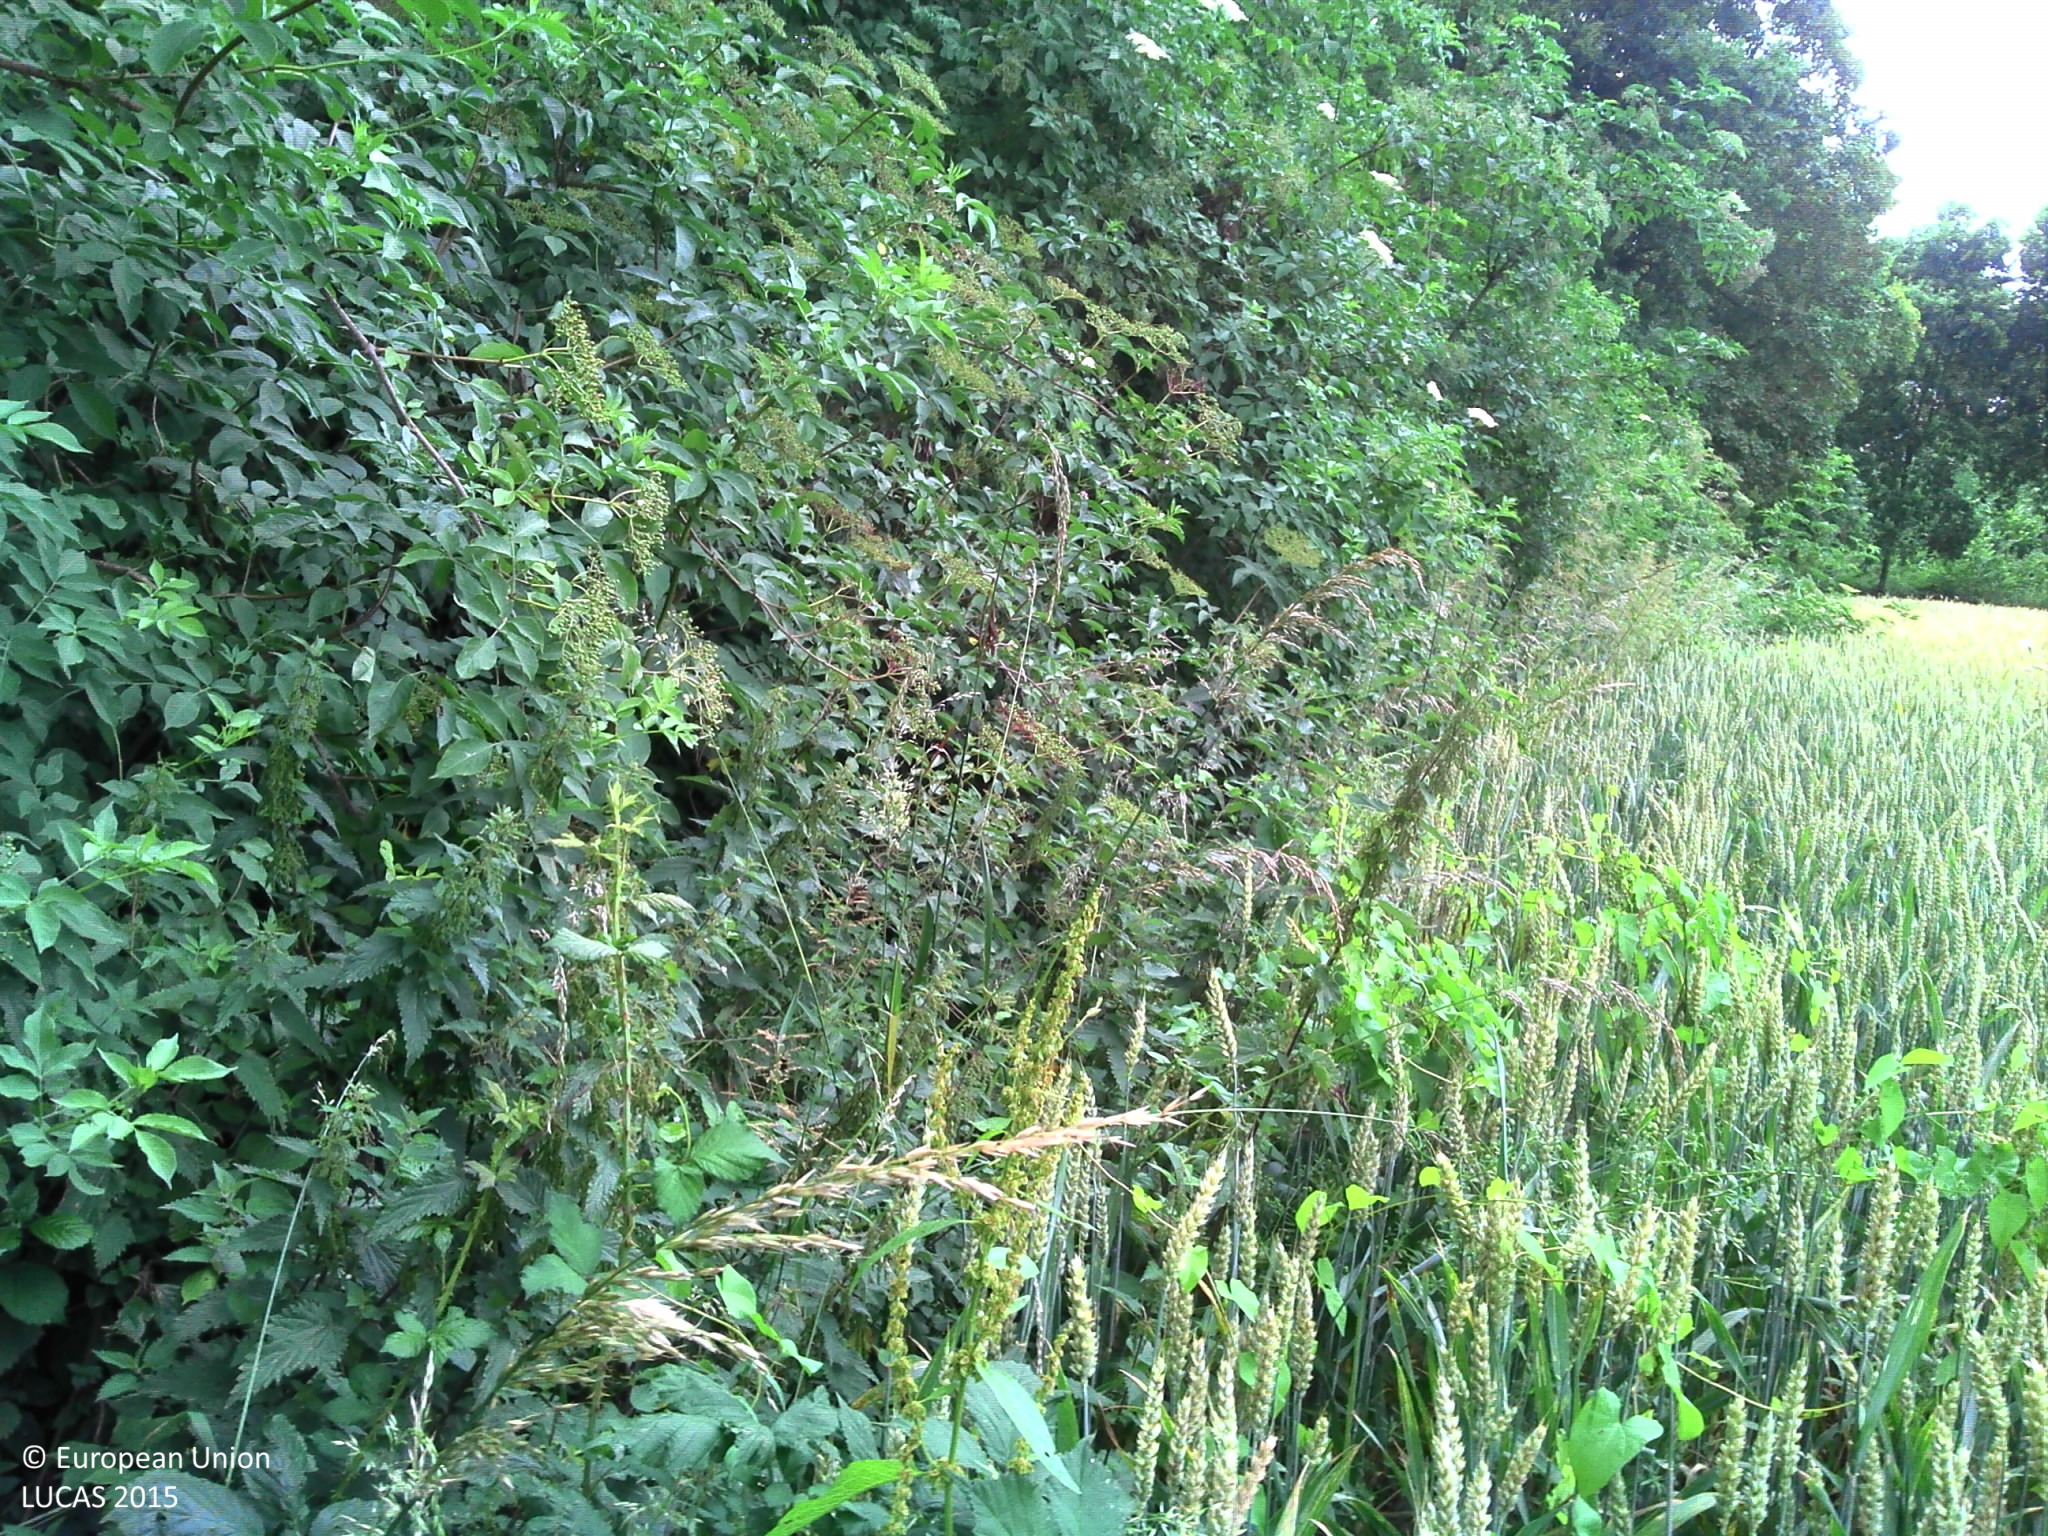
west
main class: Cropland
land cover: Common wheat
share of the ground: > 75 %
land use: Agriculture (excluding fallow land and kitchen gardens)
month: July
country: FR
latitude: 48.2418
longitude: -2.1336
